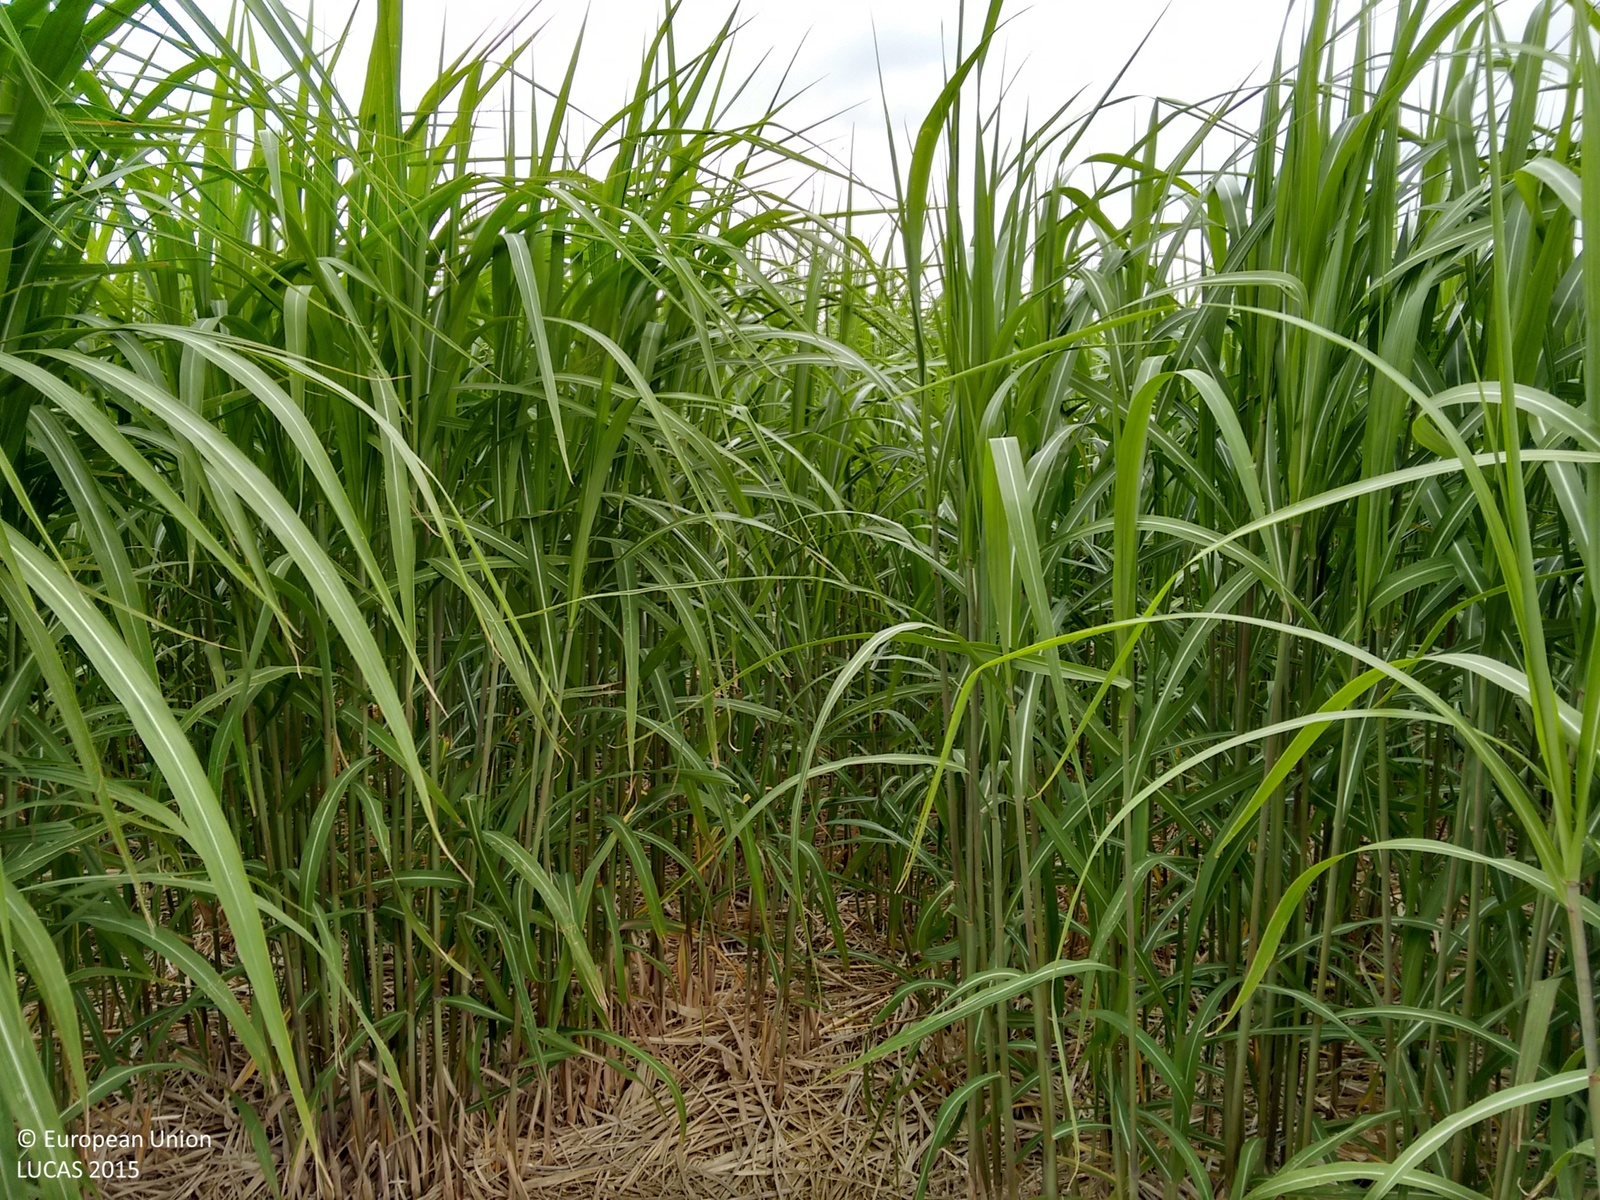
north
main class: Cropland
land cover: Permanent industrial crops
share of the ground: > 75 %
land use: Agriculture (excluding fallow land and kitchen gardens)
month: July
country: GB
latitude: 52.5077
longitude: -0.5137
